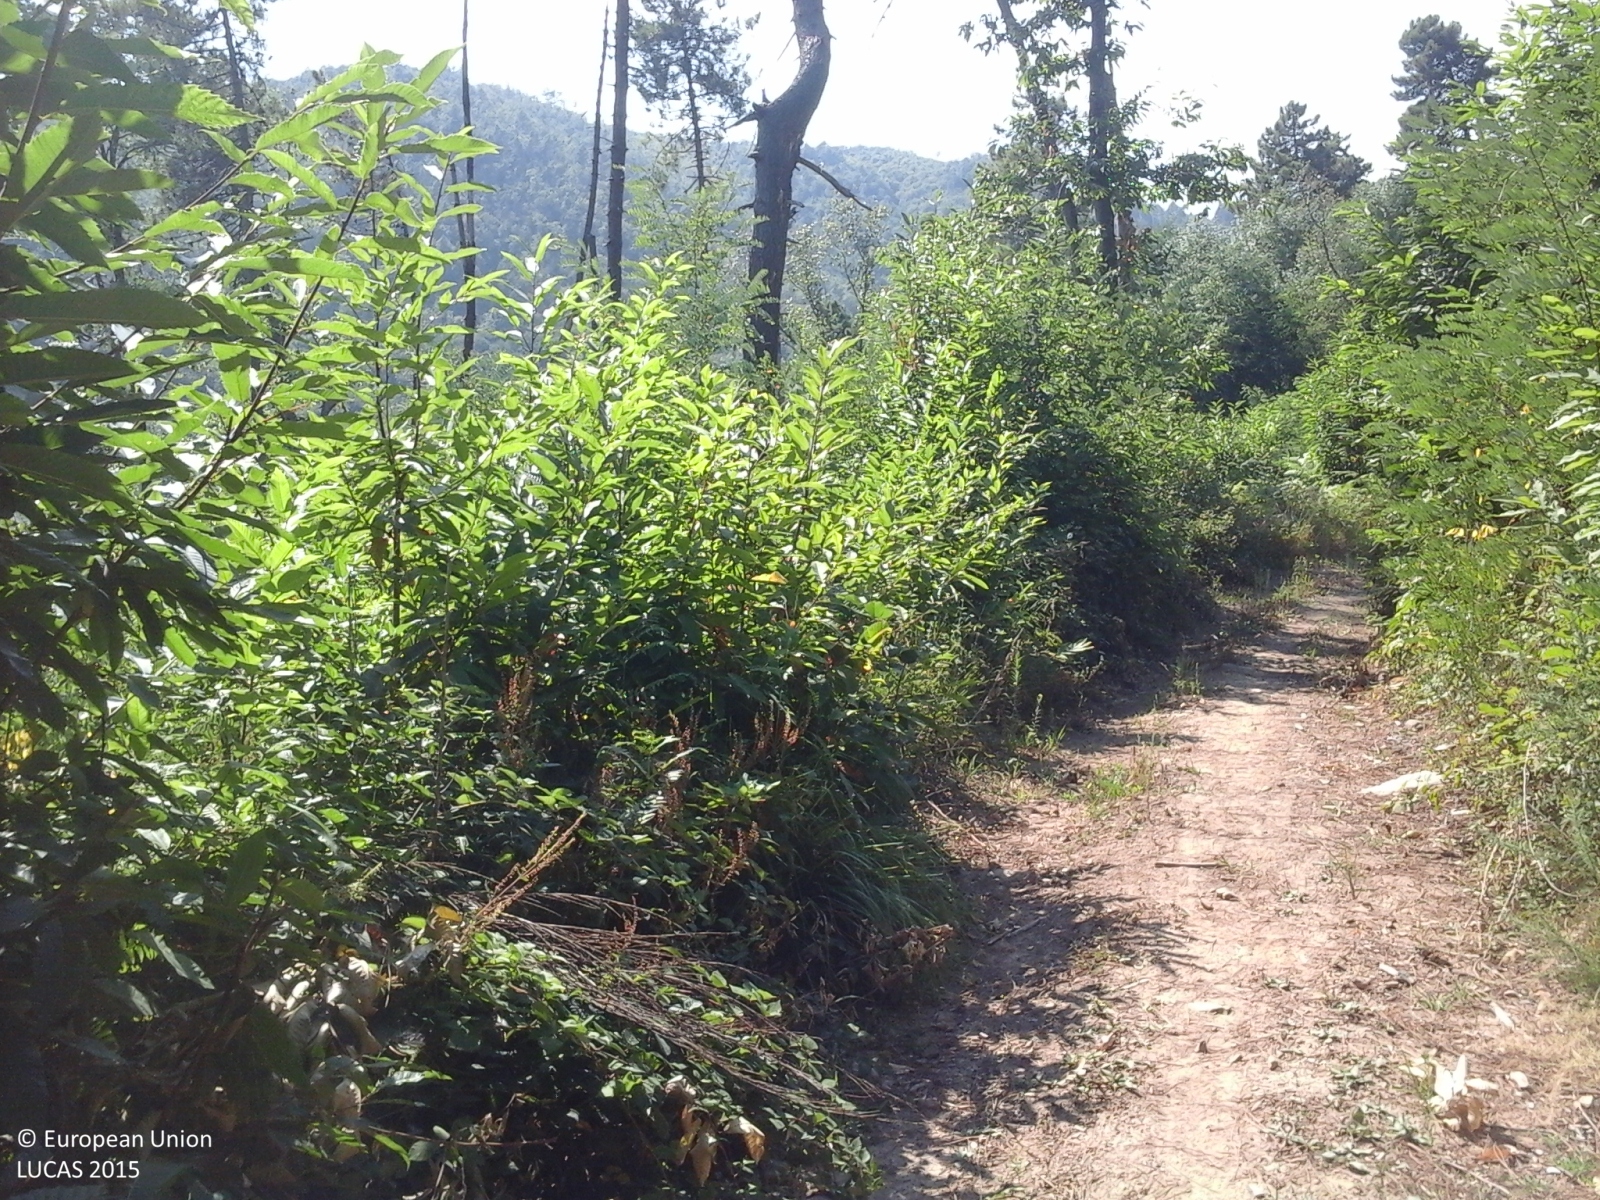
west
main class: Woodland
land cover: Other mixed woodland
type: thermophilous deciduous forest
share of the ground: > 75 %
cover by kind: broadleaved forest trees 60 %, coniferous forest trees 40 %
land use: Forestry
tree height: > 5 m
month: August
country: IT
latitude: 43.9329
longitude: 10.7579
